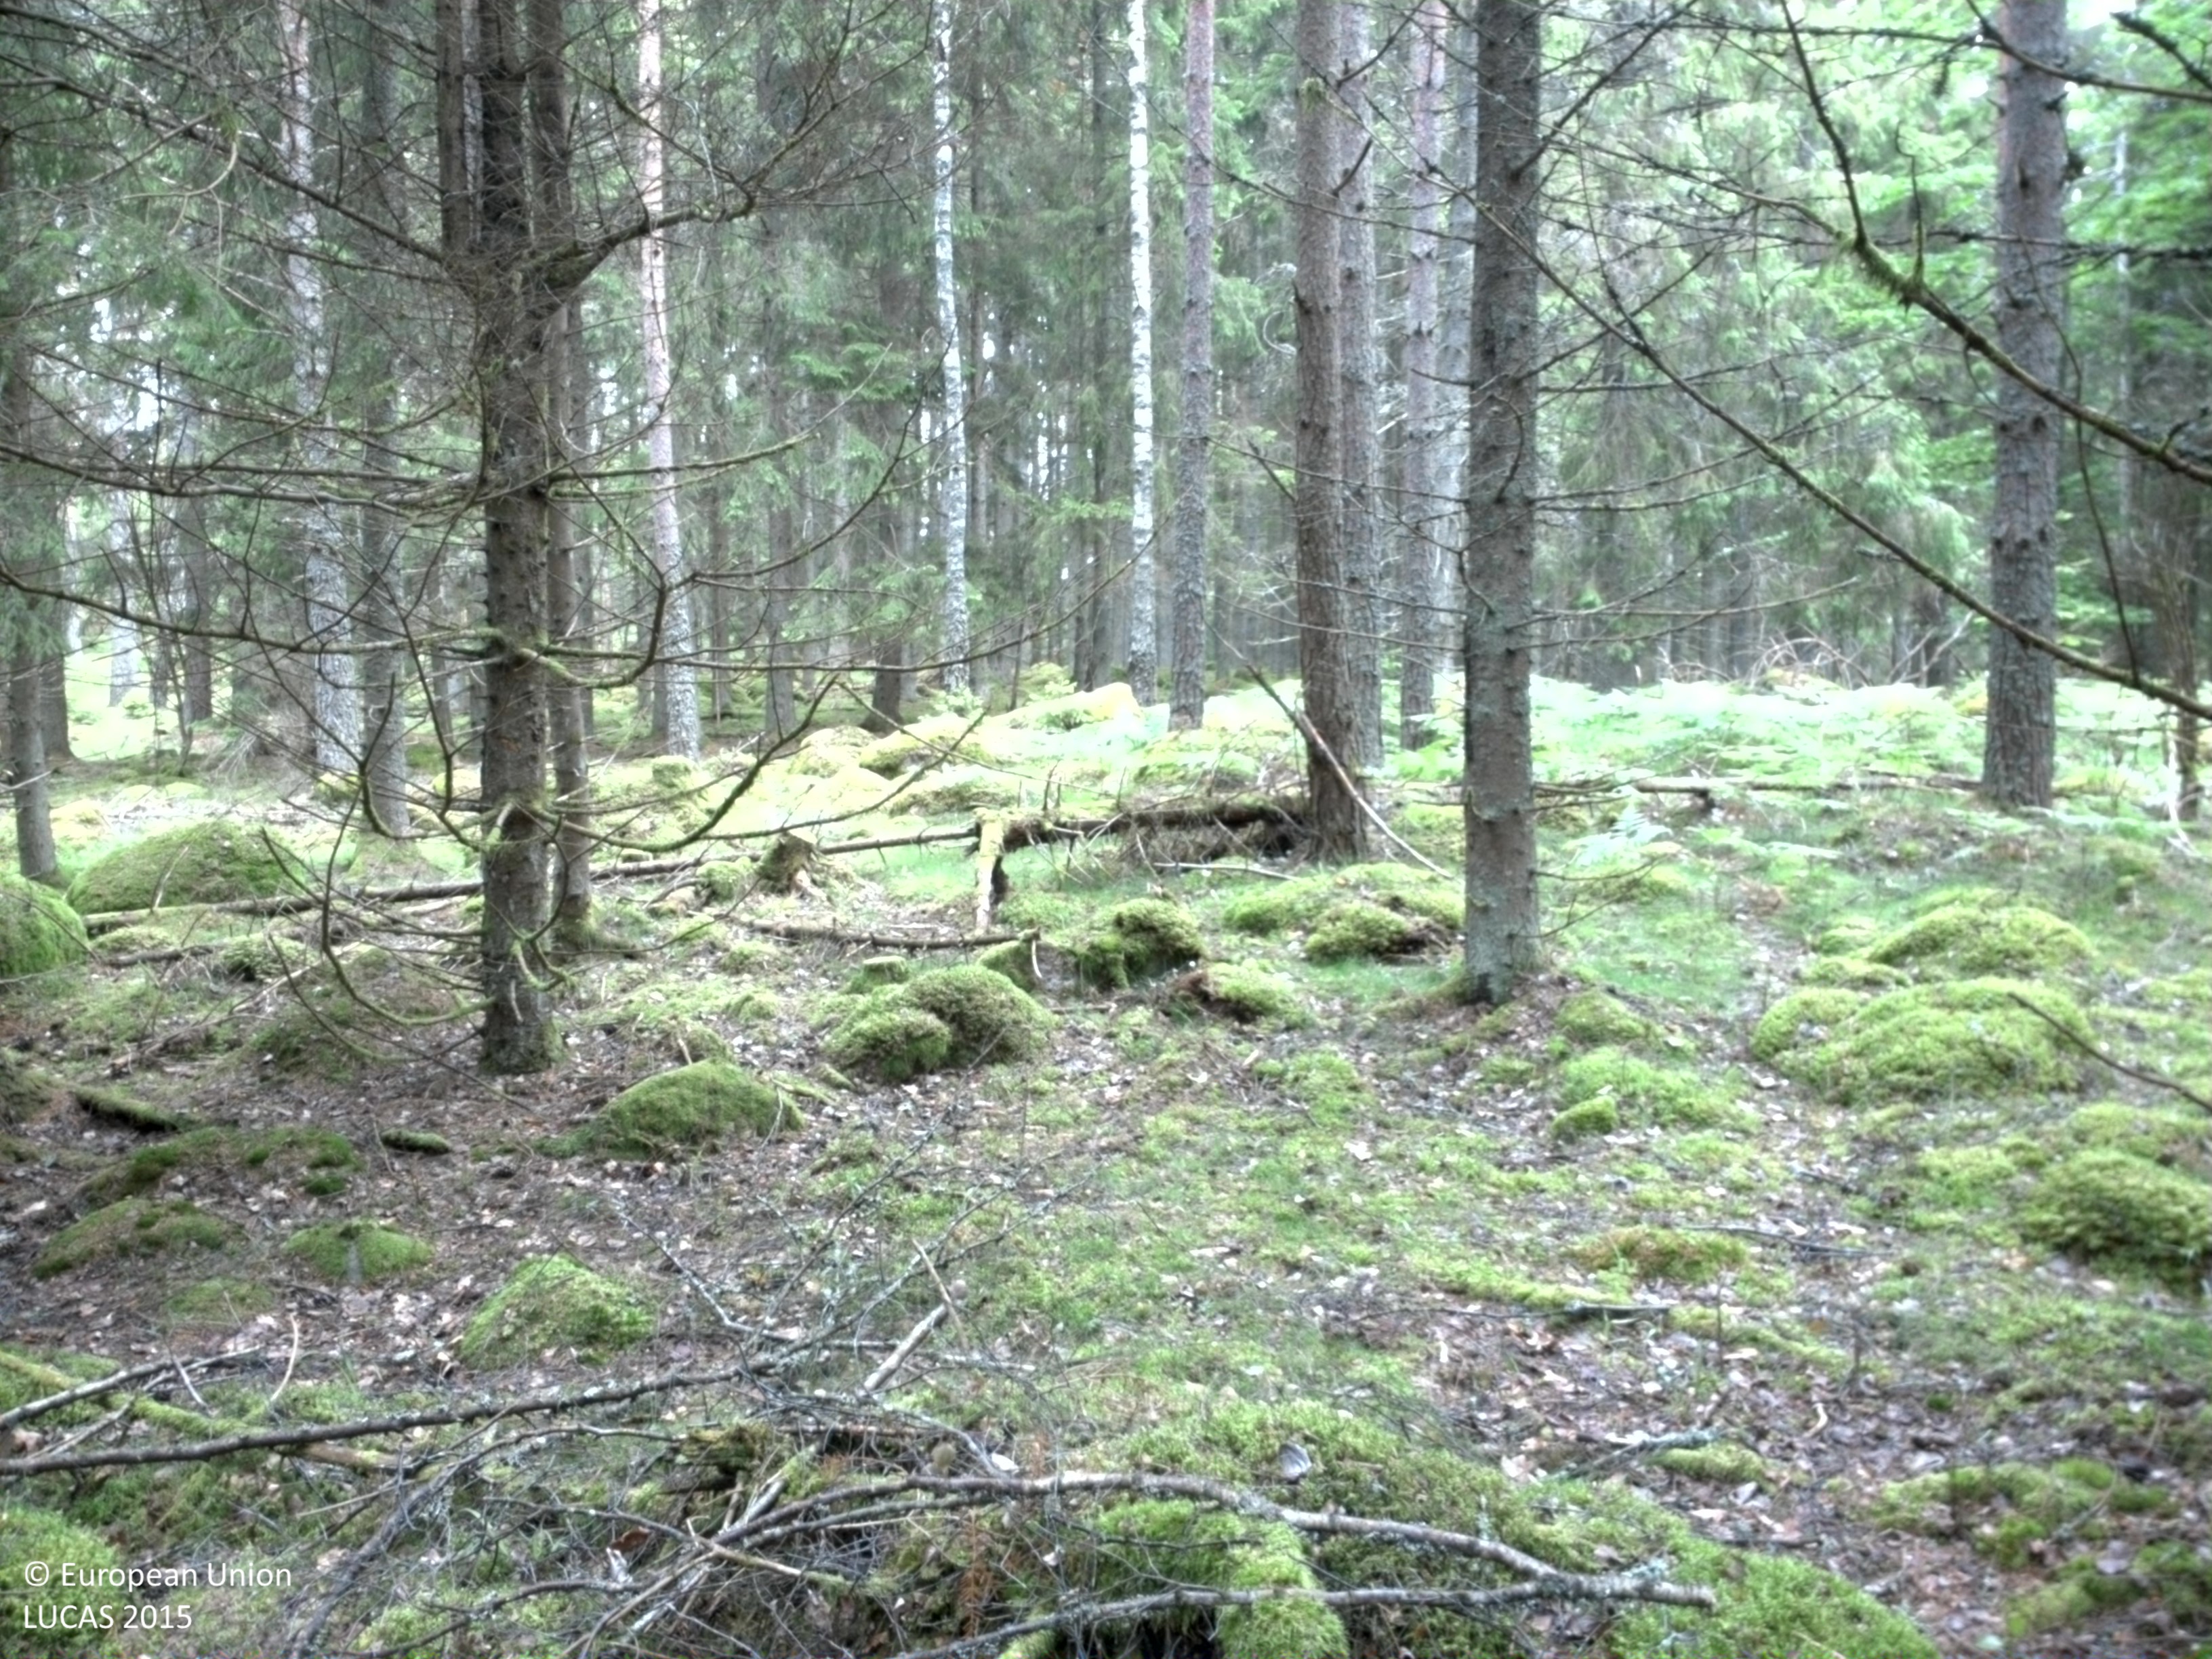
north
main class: Woodland
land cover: Spruce dominated coniferous woodland
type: boreal forest
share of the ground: 50 - 75 %
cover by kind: coniferous forest trees 70 %, lichens and mosses 30 %
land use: Forestry
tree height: > 5 m
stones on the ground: 10 - 25 %
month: June
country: SE
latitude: 58.5367
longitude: 15.5767
